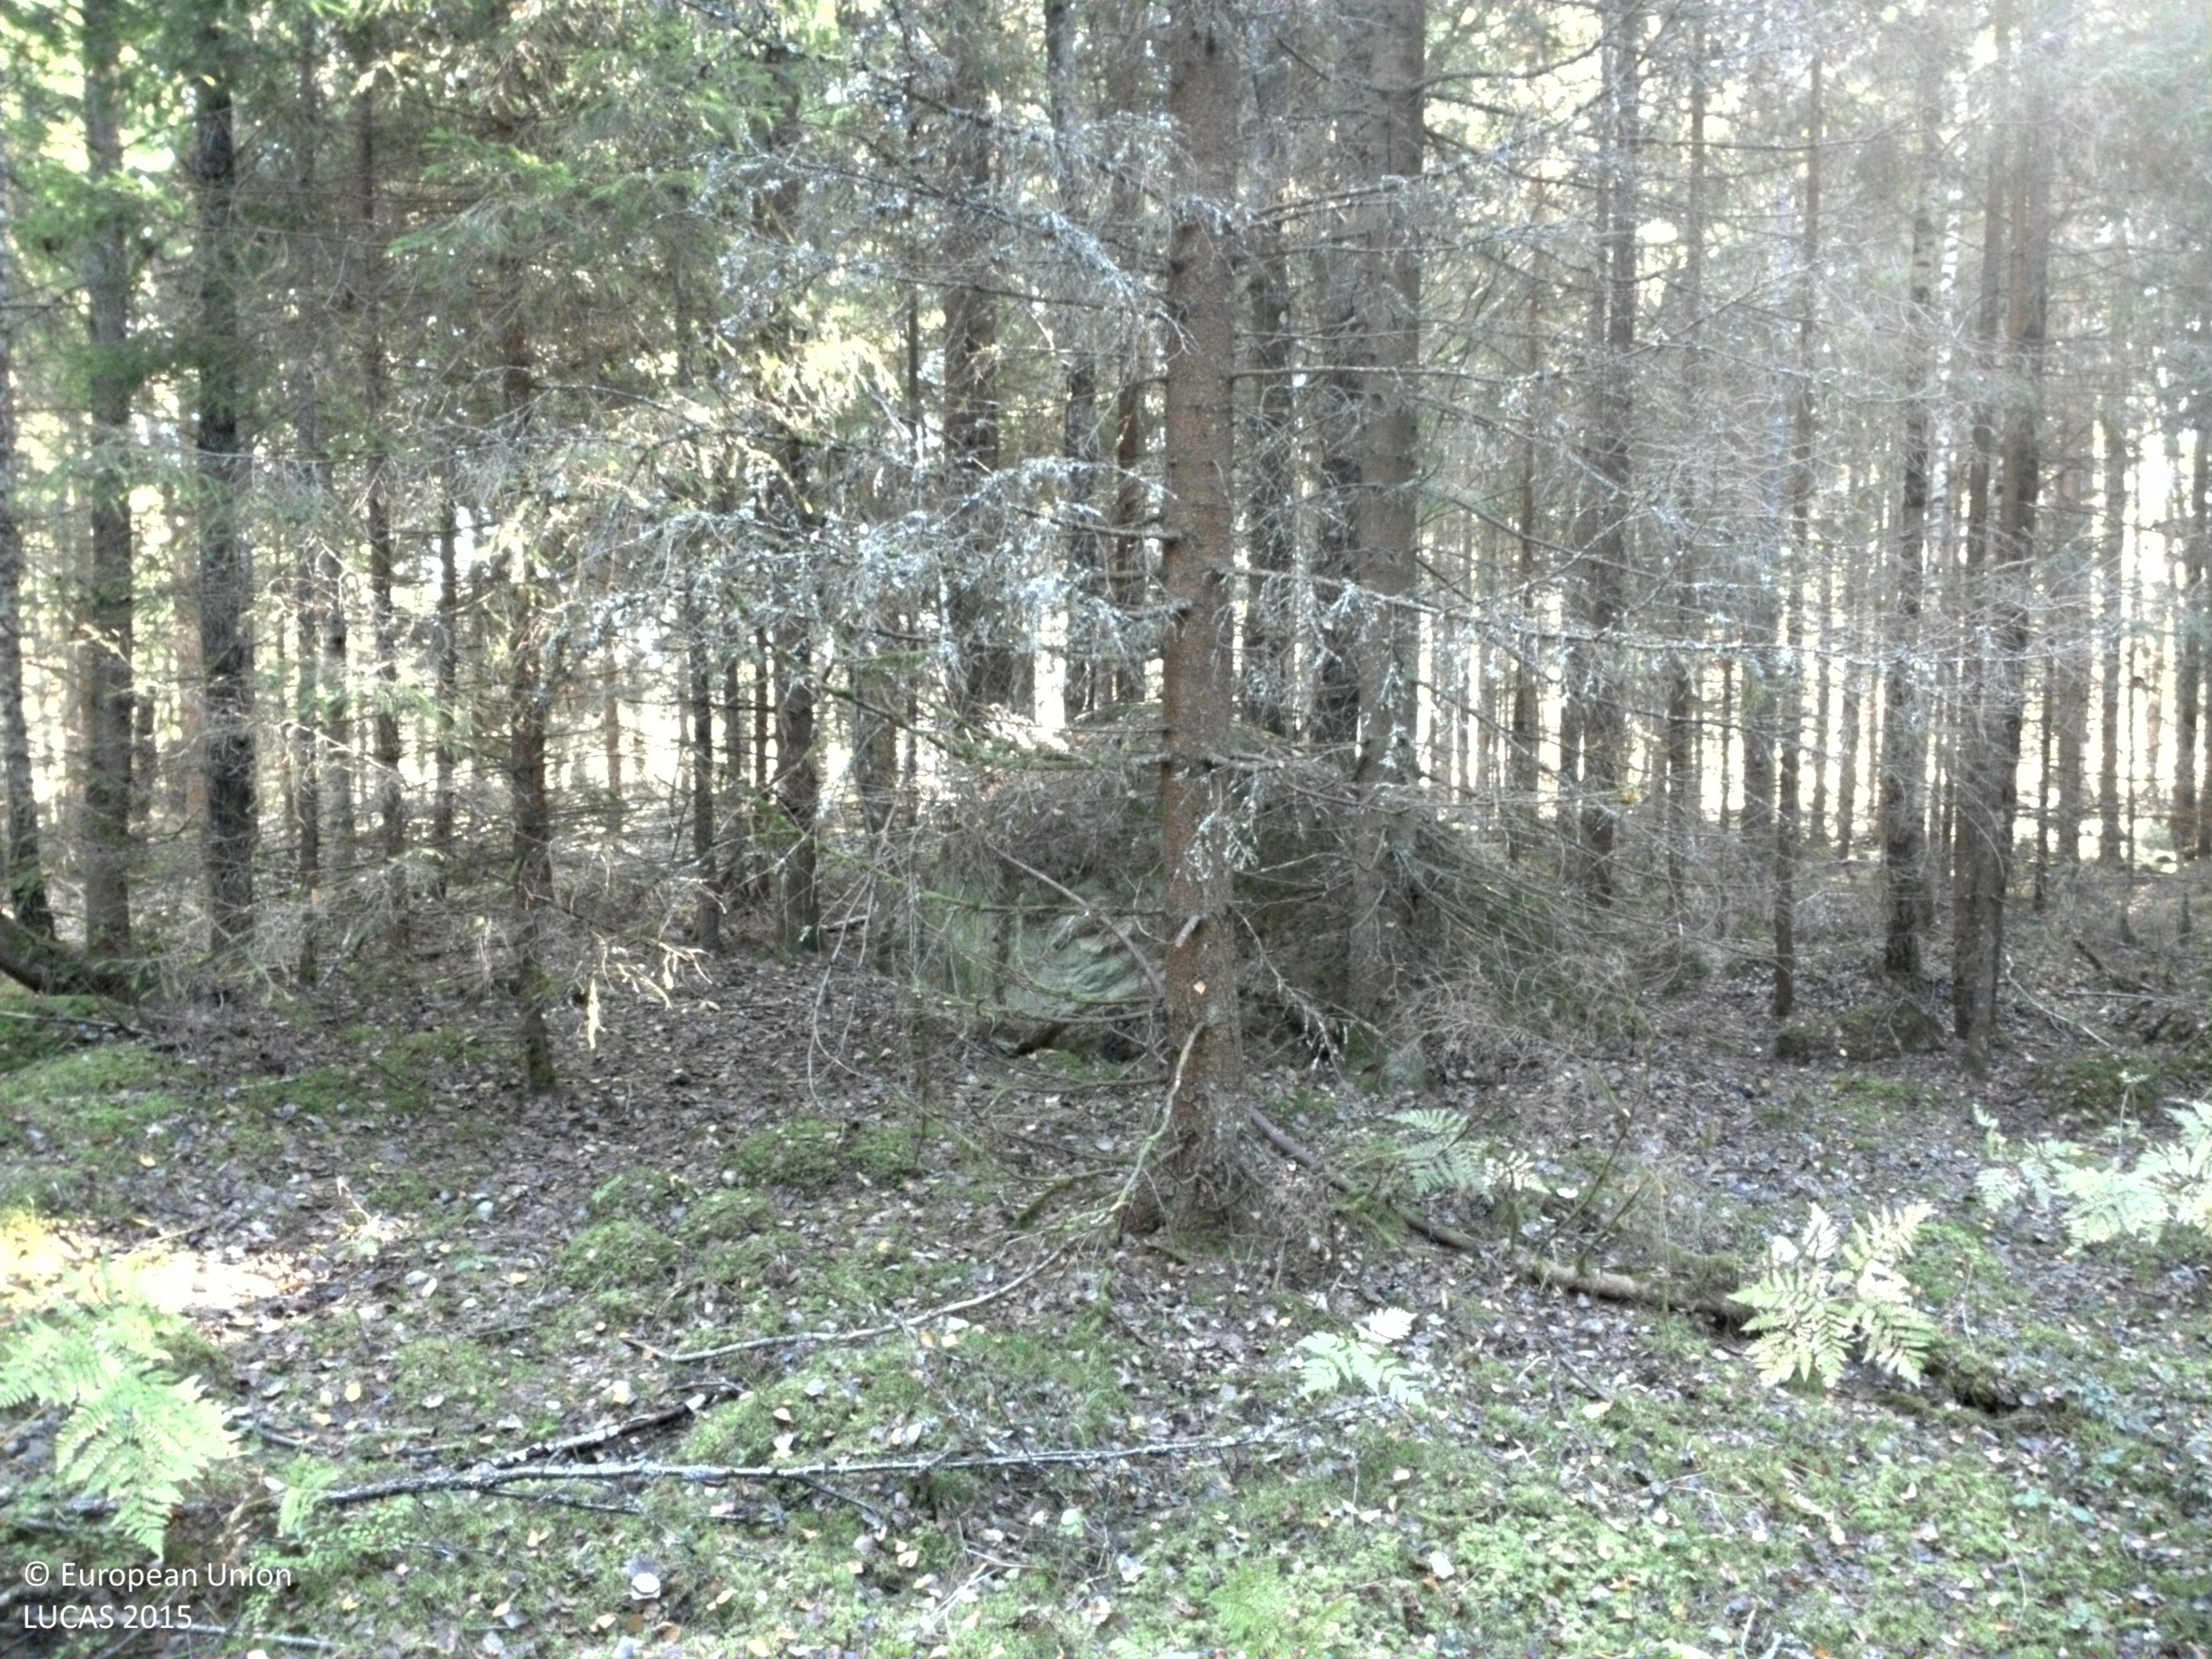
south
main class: Woodland
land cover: Spruce dominated mixed woodland
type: boreal forest
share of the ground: 10 - 25 %
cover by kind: lichens and mosses 65 %, coniferous forest trees 15 %, broadleaved forest trees 10 %, herbaceous plants 10 %
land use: Forestry
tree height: > 5 m
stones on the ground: 10 - 25 %
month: September
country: SE
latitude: 59.0950
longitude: 14.0594
